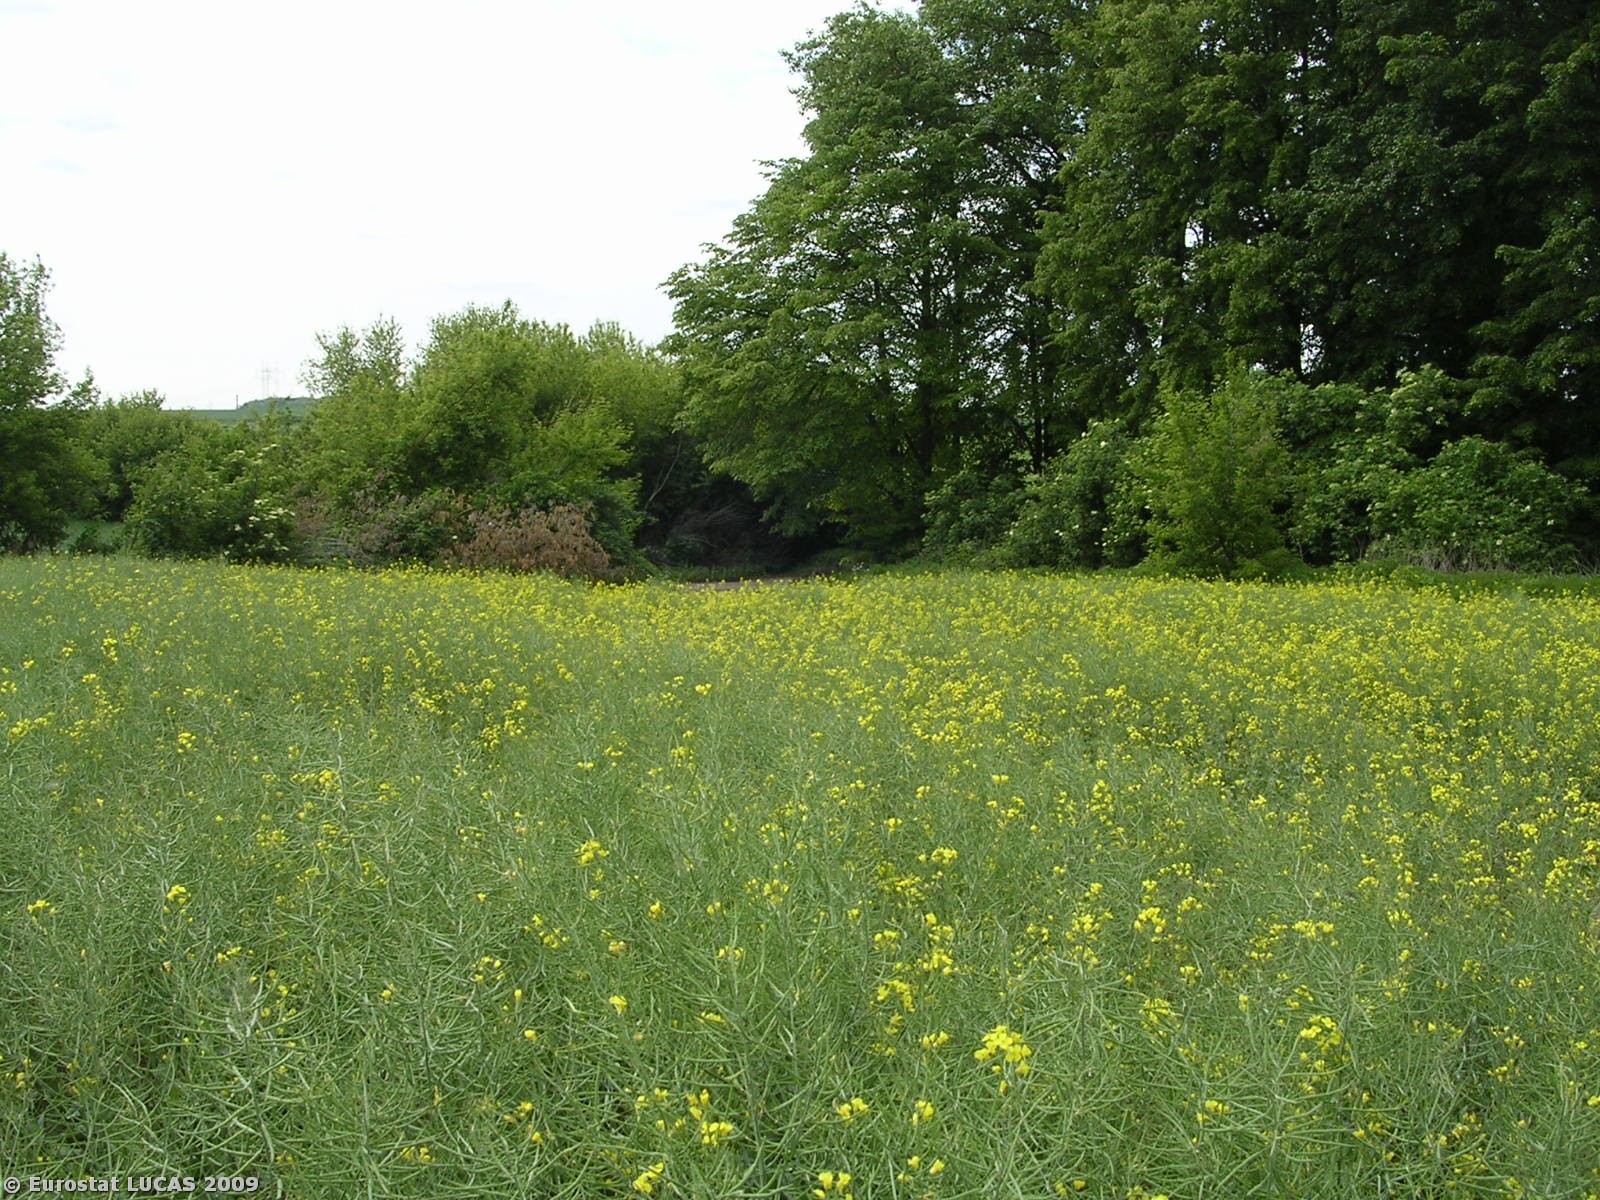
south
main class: Cropland
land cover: Rape and turnip rape
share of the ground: > 75 %
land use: Agriculture (excluding fallow land and kitchen gardens)
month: May
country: CZ
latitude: 50.1598
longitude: 14.6913
